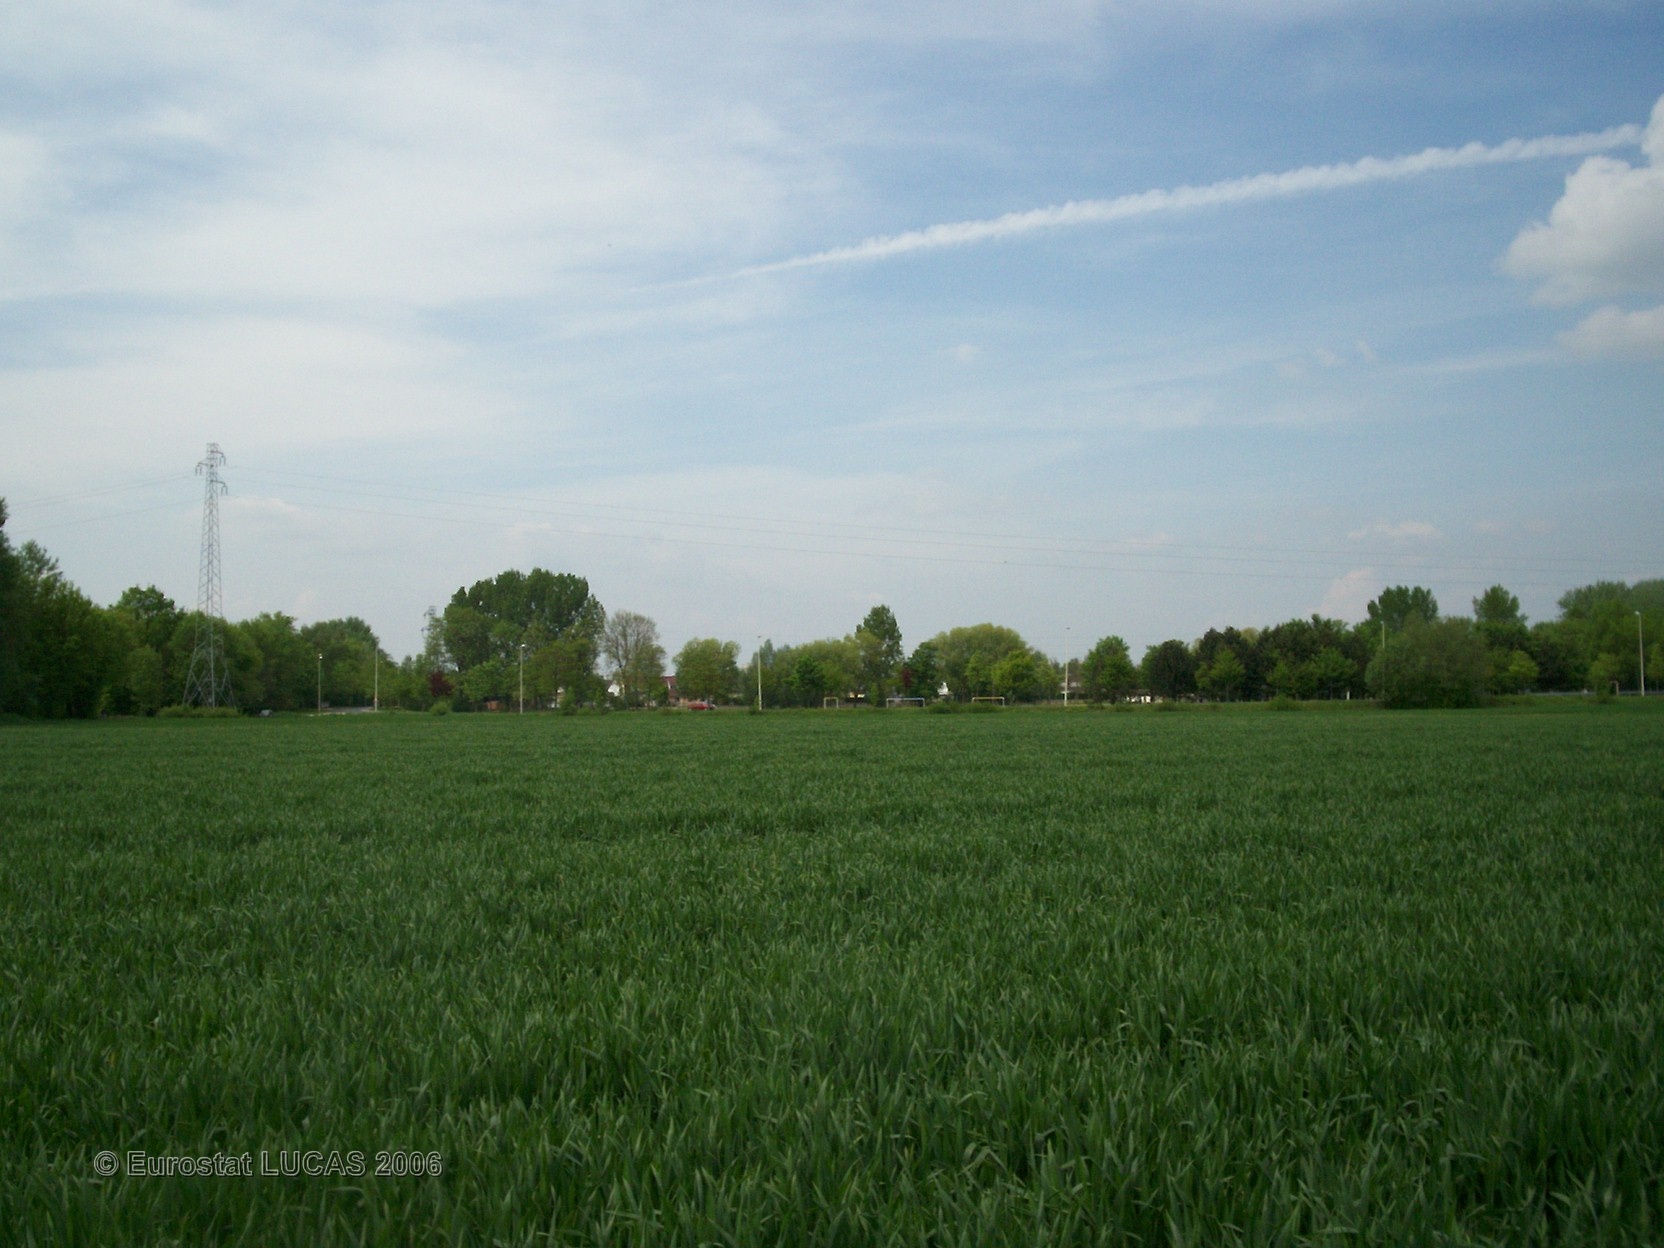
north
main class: Cropland
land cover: Common wheat
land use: Agriculture (excluding fallow land and kitchen gardens)
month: May
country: FR
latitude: 48.9282
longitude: 4.3866
